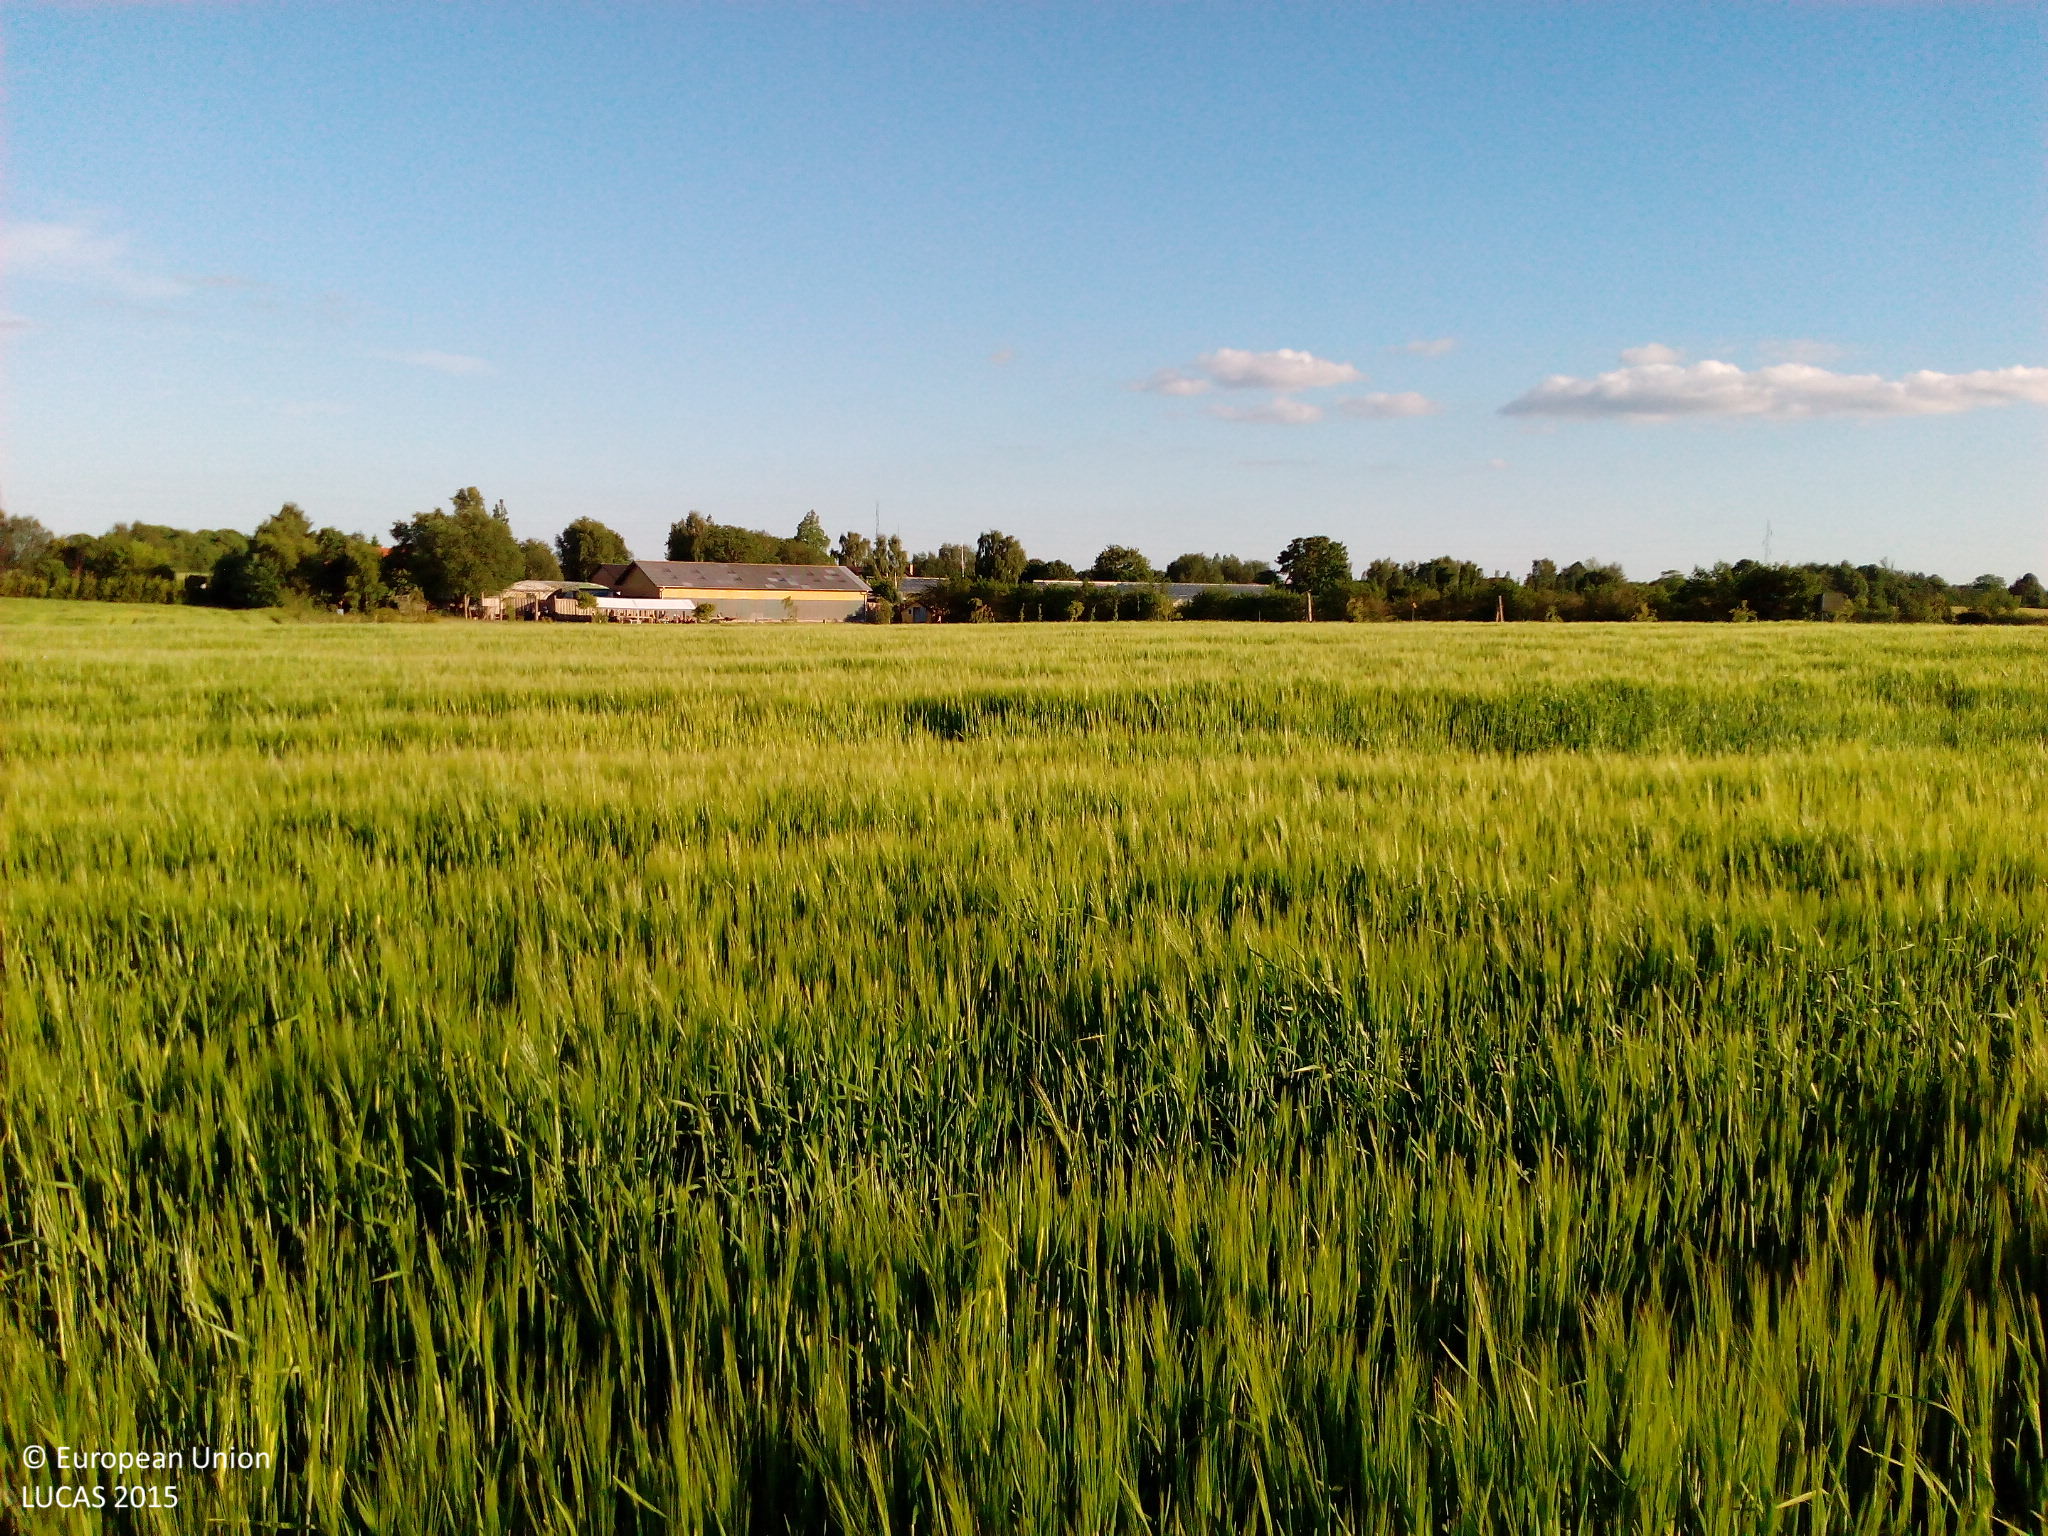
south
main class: Cropland
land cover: Triticale
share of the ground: > 75 %
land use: Agriculture (excluding fallow land and kitchen gardens)
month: June
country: DK
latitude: 56.3473
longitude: 10.7595
